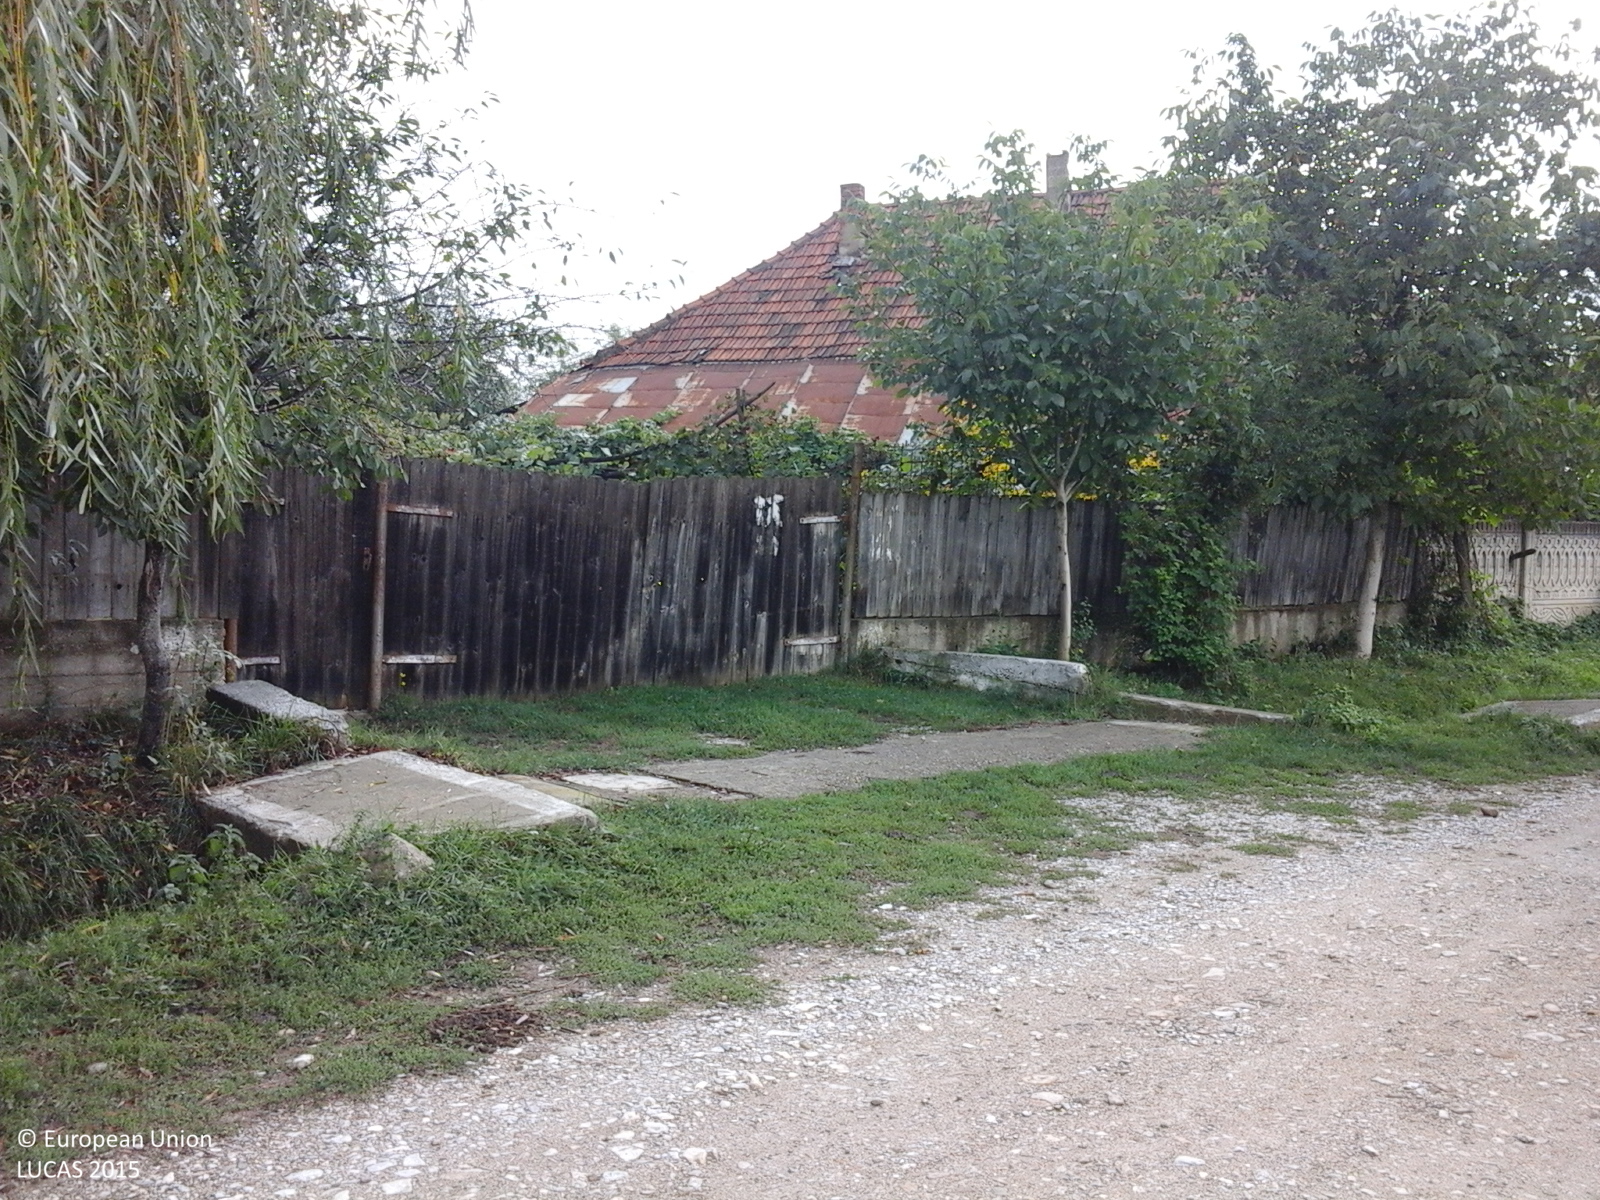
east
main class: Cropland
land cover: Maize
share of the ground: > 75 %
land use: Agriculture (excluding fallow land and kitchen gardens)
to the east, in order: Maize; Fences; Other fruit trees and berries; Electric lines; Fences; Artificial constructions in urban areas; Permanent crops (only in case pi); Common wheat; Artificial constructions in urban areas; Arable land (only in case pi); Grassland without tree/shrub cover; Permanent crops (only in case pi)
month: September
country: RO
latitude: 45.0231
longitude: 23.4455
